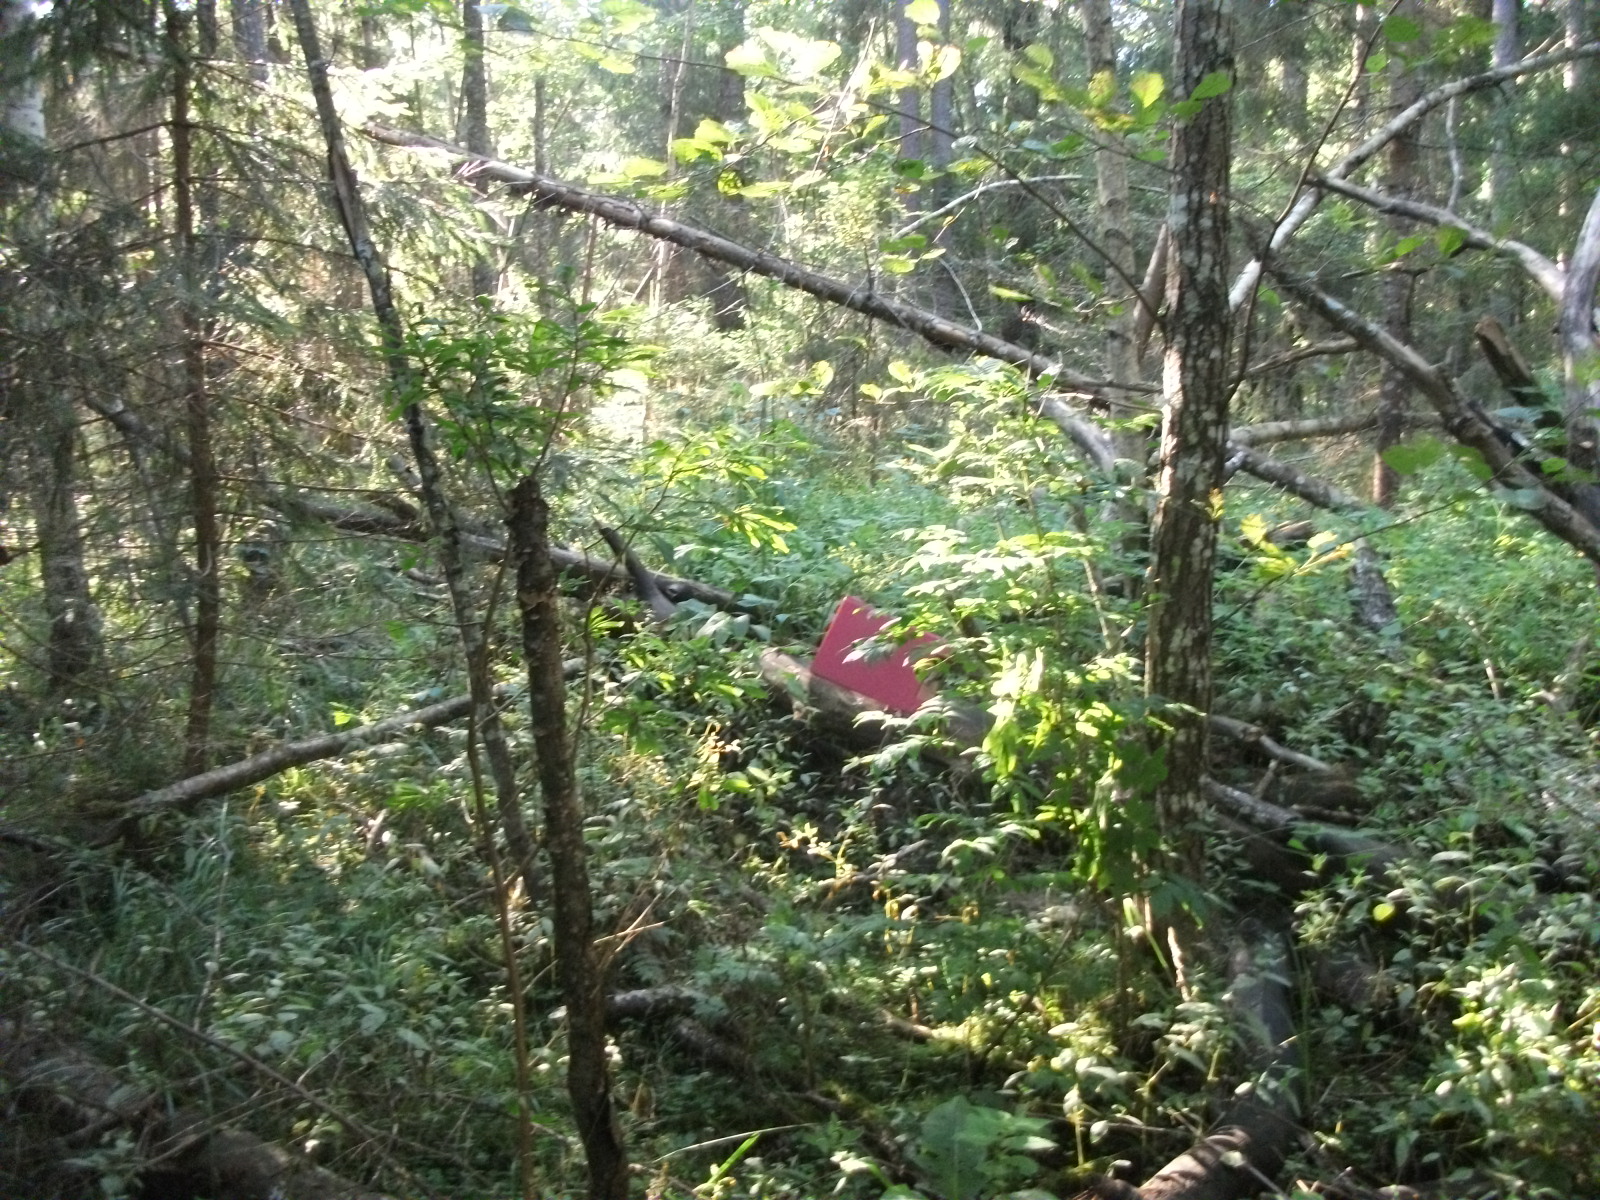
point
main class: Woodland
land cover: Spruce dominated mixed woodland
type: hemiboreal forest and nemoral coniferous forest and mixed broadleaved-coniferous forest
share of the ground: > 75 %
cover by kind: coniferous forest trees 50 %, broadleaved forest trees 30 %, herbaceous plants 15 %, shrubs 5 %
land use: Forestry
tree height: > 5 m
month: August
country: LV
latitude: 56.7098
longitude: 26.4988
